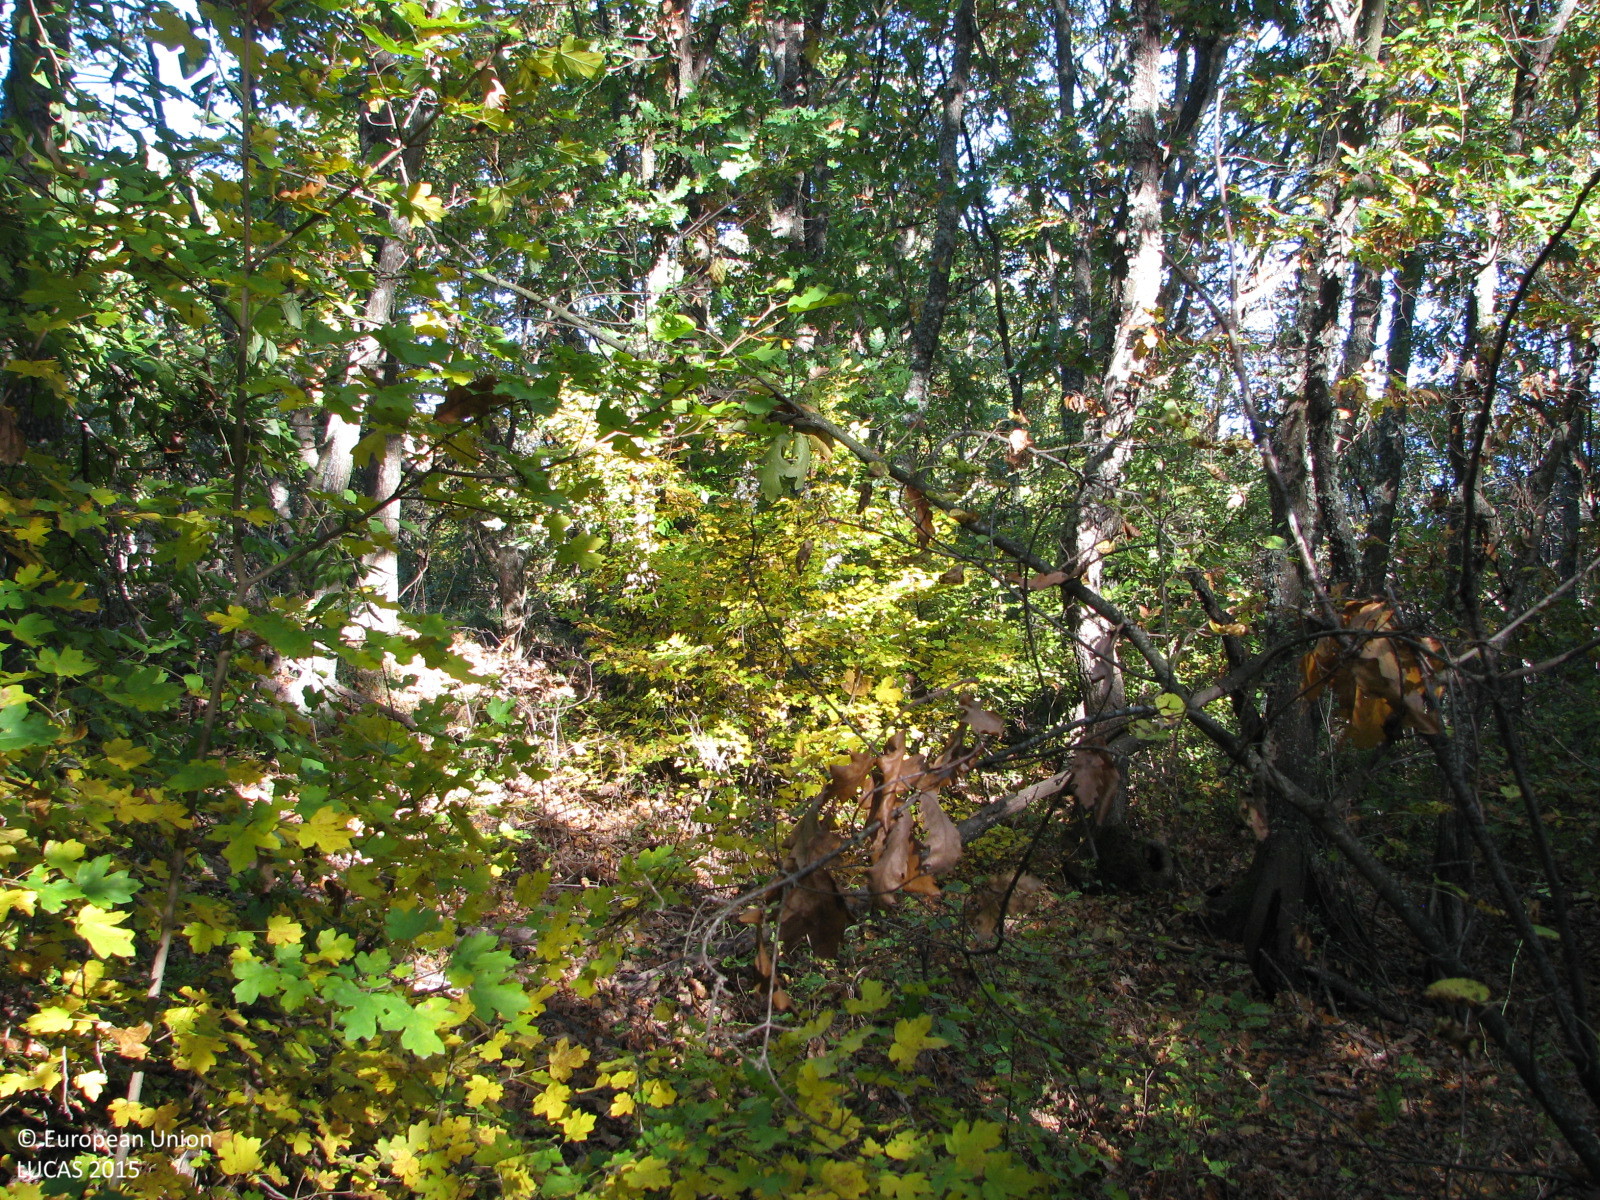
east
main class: Woodland
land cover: Broadleaved woodland
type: thermophilous deciduous forest
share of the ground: 50 - 75 %
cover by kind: broadleaved forest trees 70 %, unconsolidated bare surface 20 %, shrubs 10 %
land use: Forestry
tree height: > 5 m
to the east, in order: Broadleaved woodland; Grass margins; Rape and turnip rape
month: October
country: BG
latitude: 42.3469
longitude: 26.8879
